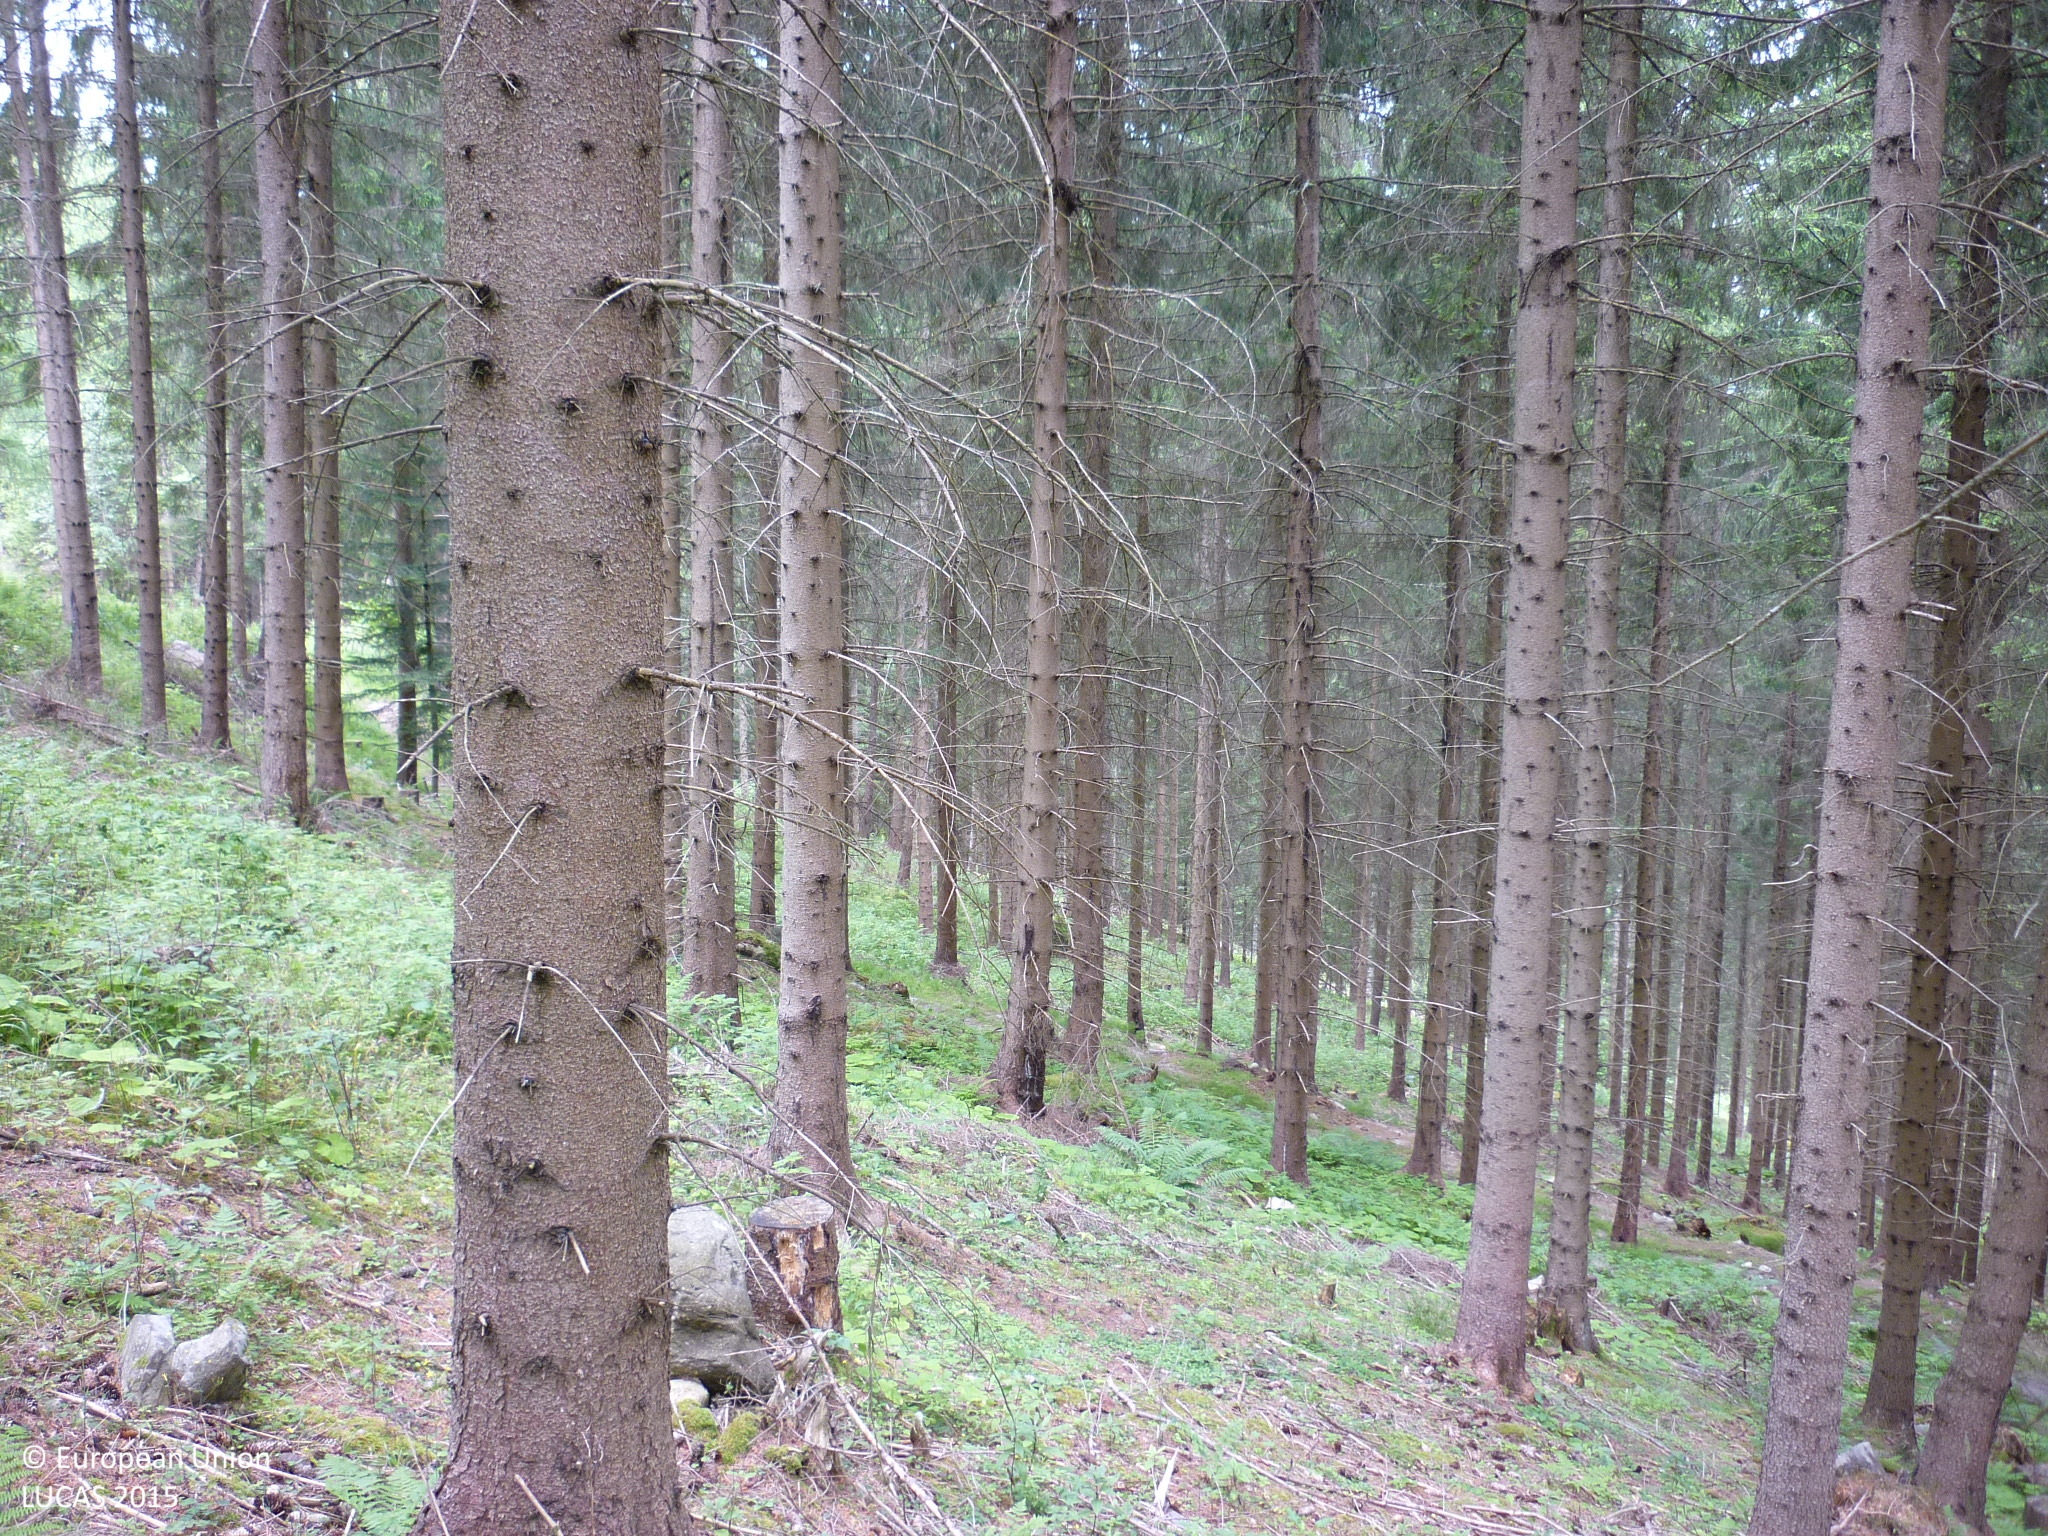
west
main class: Woodland
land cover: Spruce dominated coniferous woodland
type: alpine coniferous forest
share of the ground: > 75 %
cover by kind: coniferous forest trees 95 %, herbaceous plants 5 %
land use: Forestry
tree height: > 5 m
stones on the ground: < 10 %
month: July
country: AT
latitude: 47.2299
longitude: 14.9258
